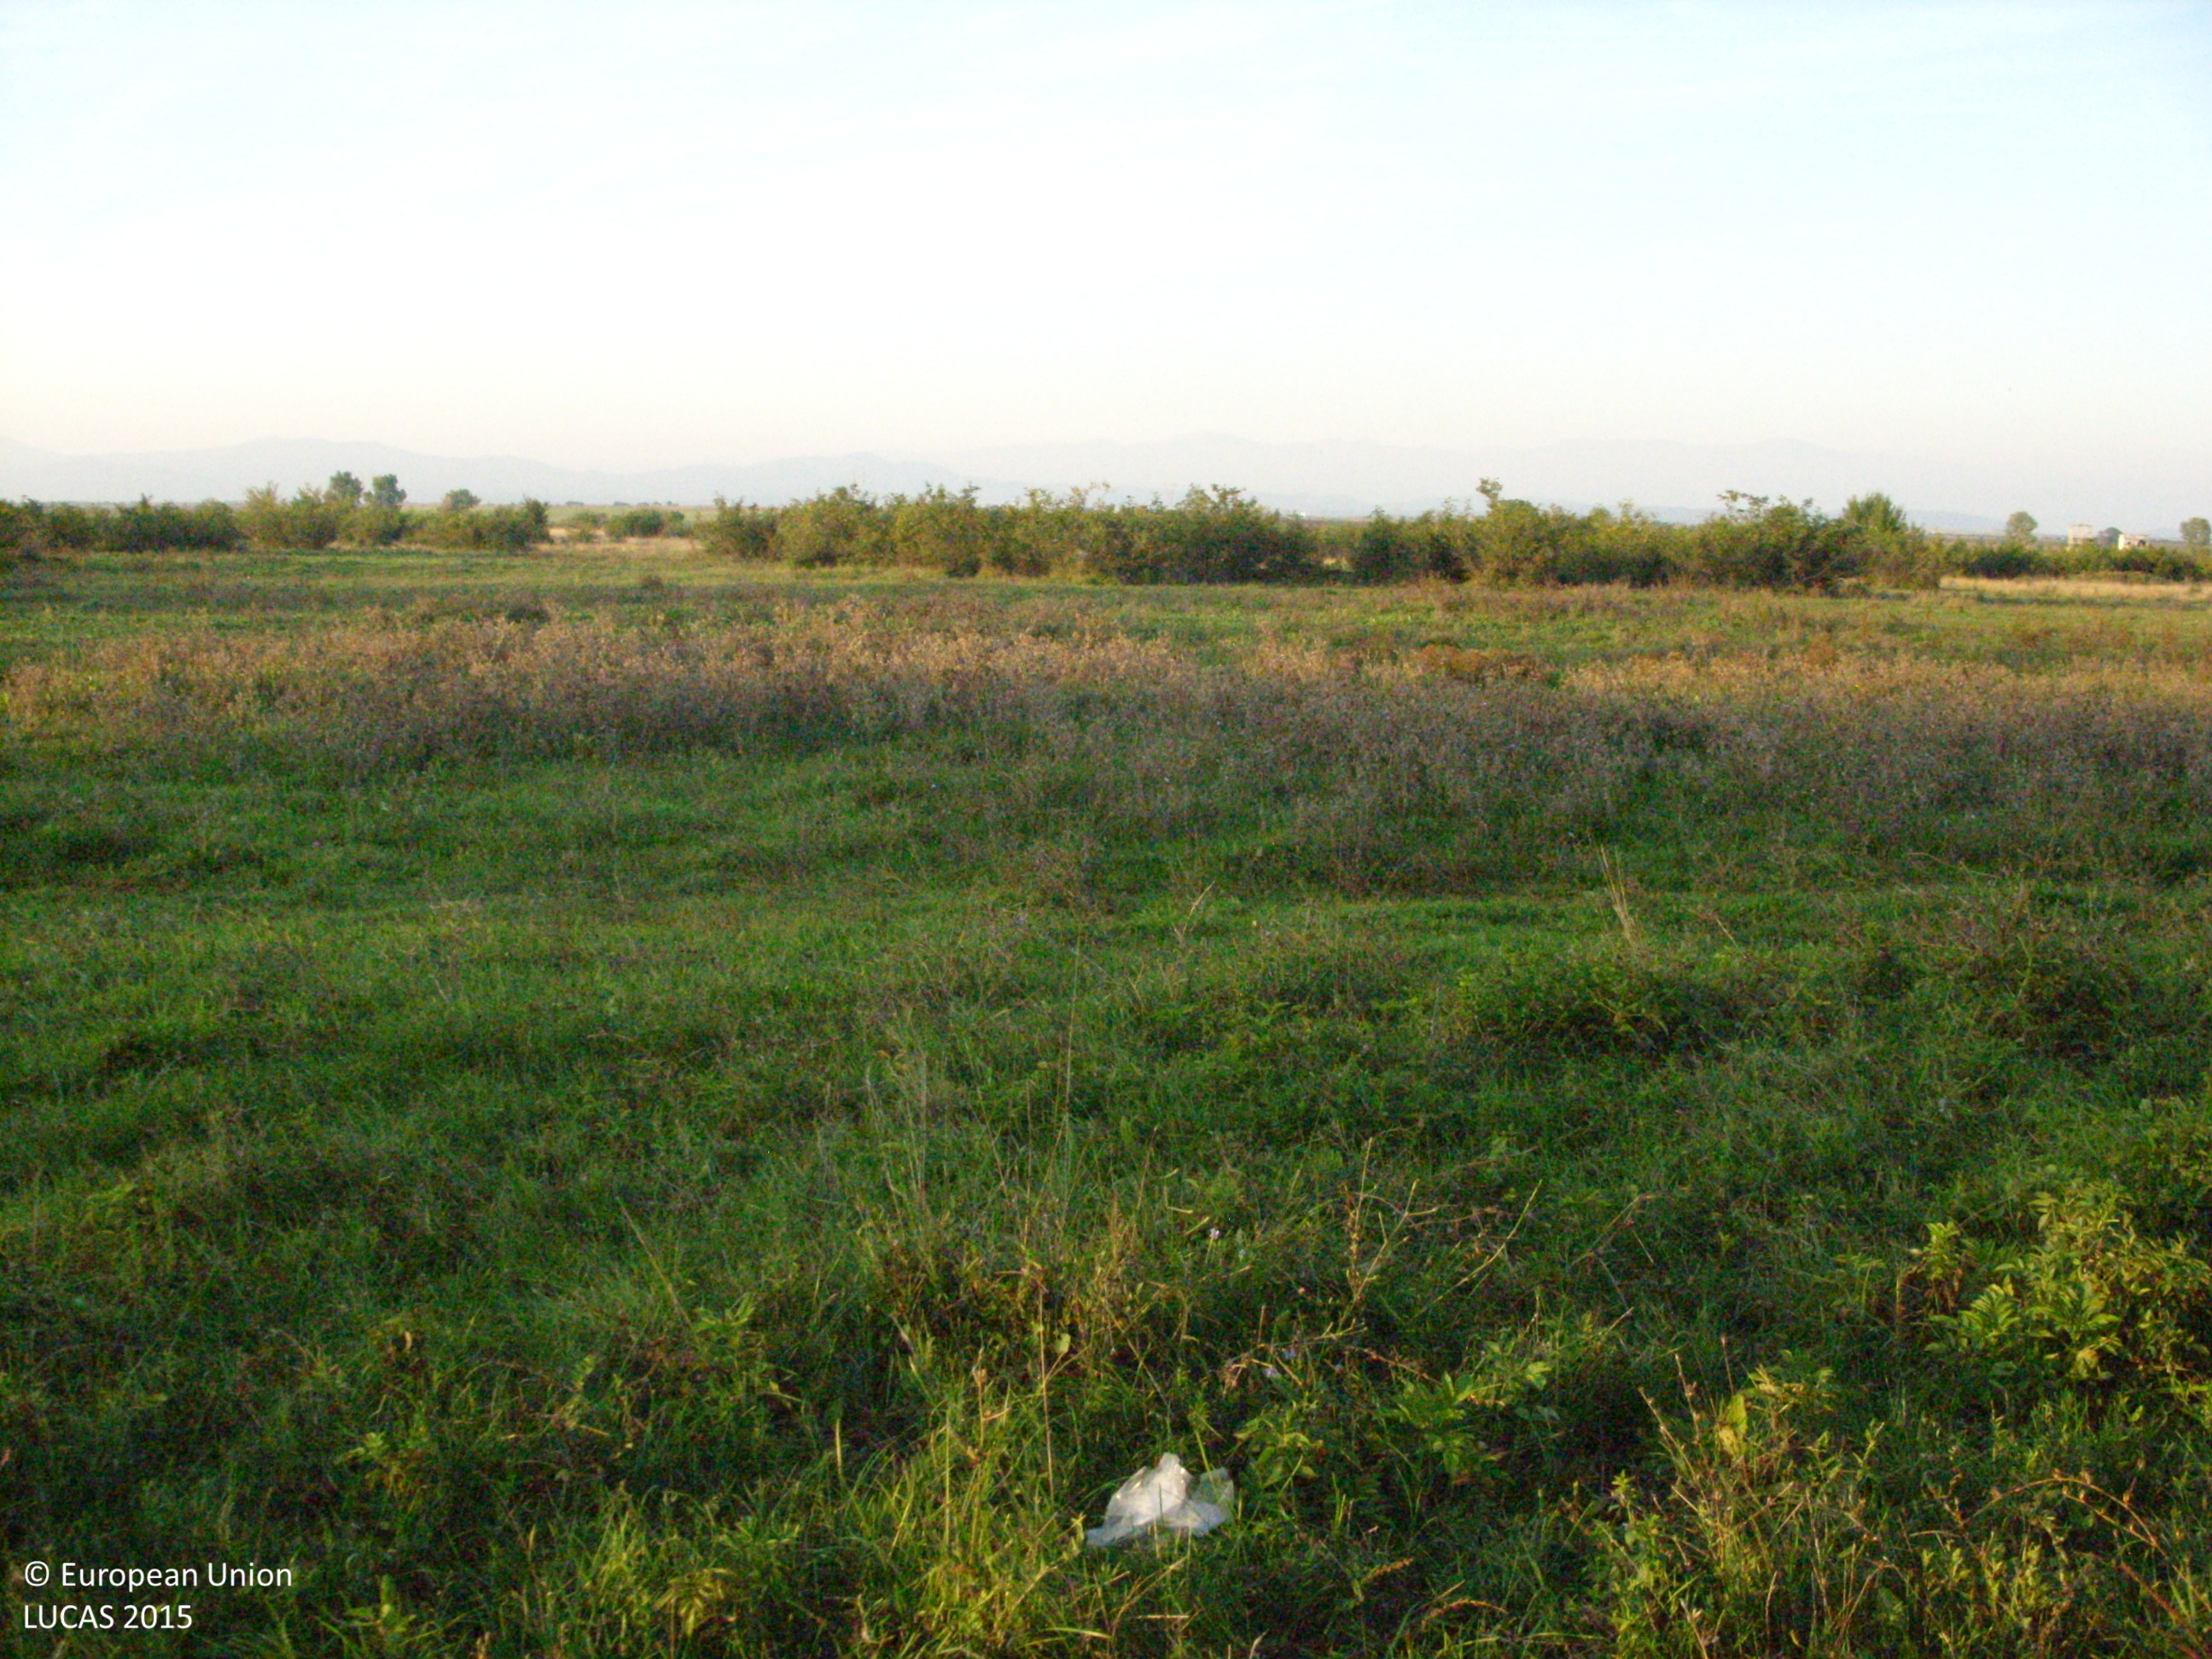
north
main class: Grassland
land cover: Grassland without tree/shrub cover
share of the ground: > 75 %
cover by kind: herbaceous plants 95 %, shrubs 5 %
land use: Agriculture (excluding fallow land and kitchen gardens)
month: October
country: BG
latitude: 42.3297
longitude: 24.6757
